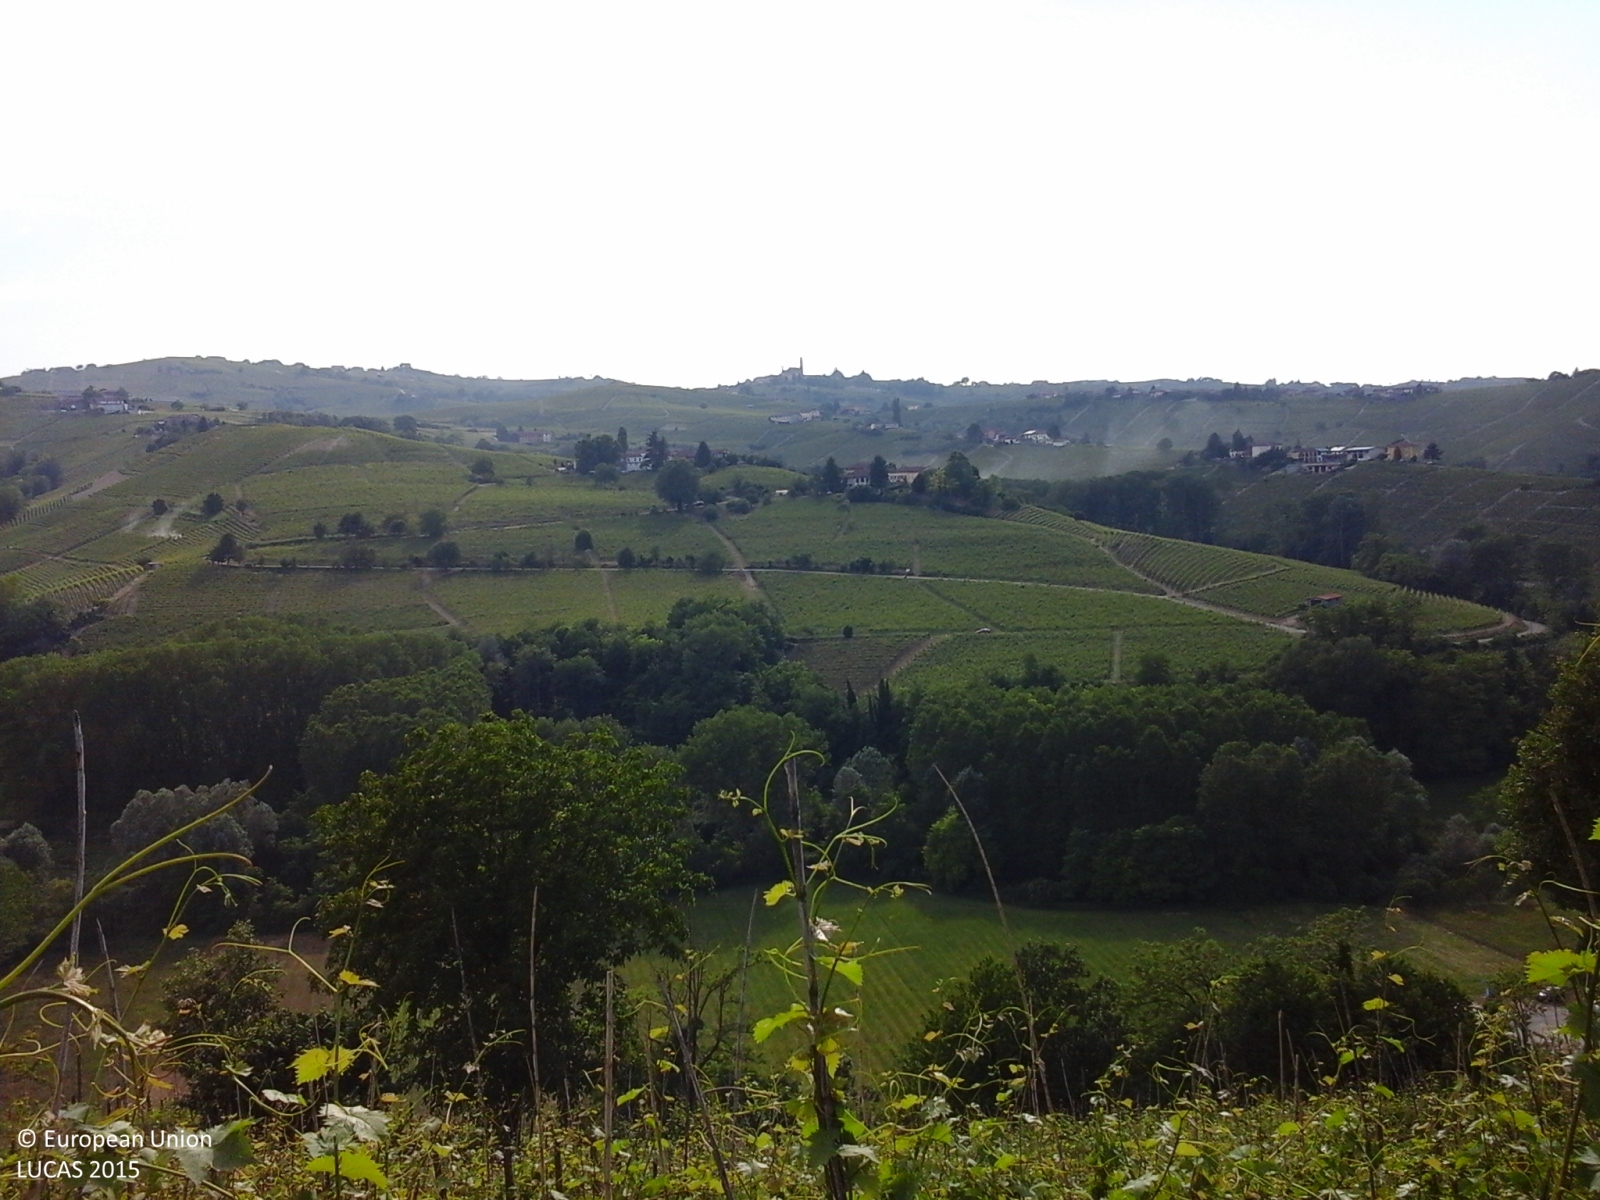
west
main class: Cropland
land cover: Vineyards
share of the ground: 25 - 50 %
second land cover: Grassland without tree/shrub cover
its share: 50 - 75 %
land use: Agriculture (excluding fallow land and kitchen gardens)
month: June
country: IT
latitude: 44.7322
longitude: 8.2231
